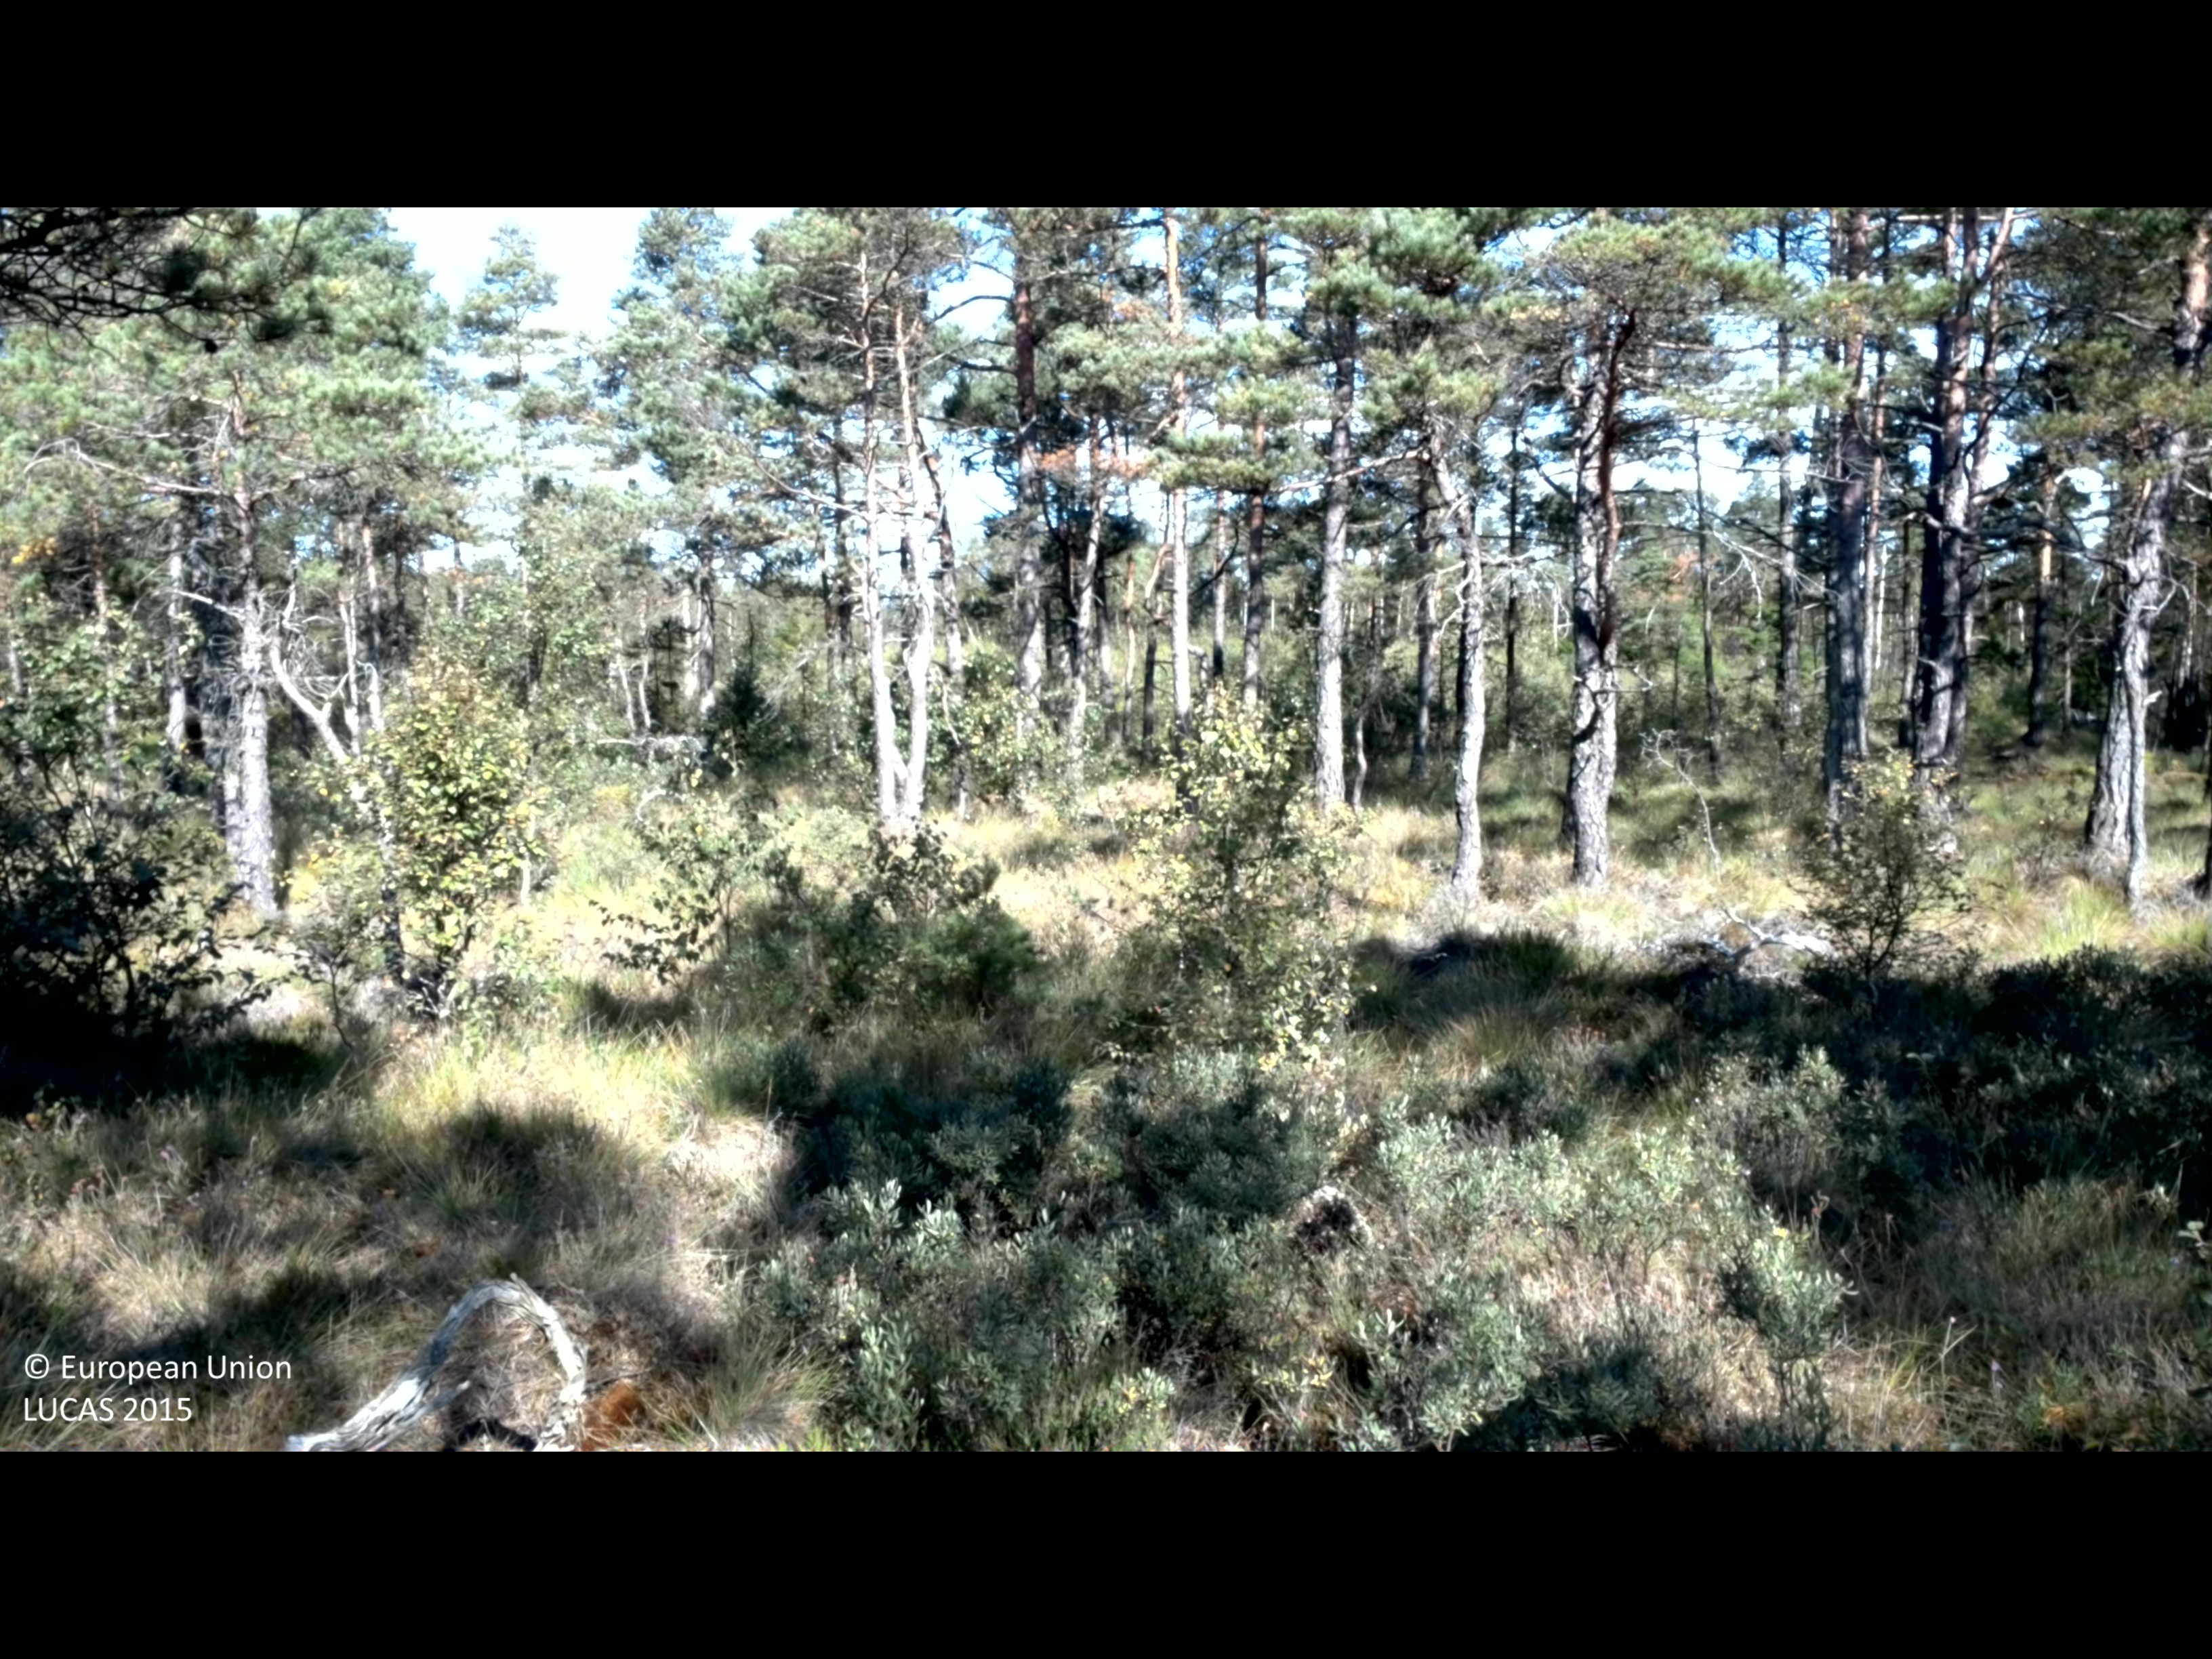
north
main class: Woodland
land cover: Pine dominated coniferous woodland
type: mire and swamp forests
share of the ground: 50 - 75 %
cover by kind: coniferous forest trees 65 %, shrubs 20 %, herbaceous plants 10 %, broadleaved forest trees 5 %
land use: Semi-natural and natural areas not in use
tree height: > 5 m
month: September
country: SE
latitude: 57.0661
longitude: 13.1792
